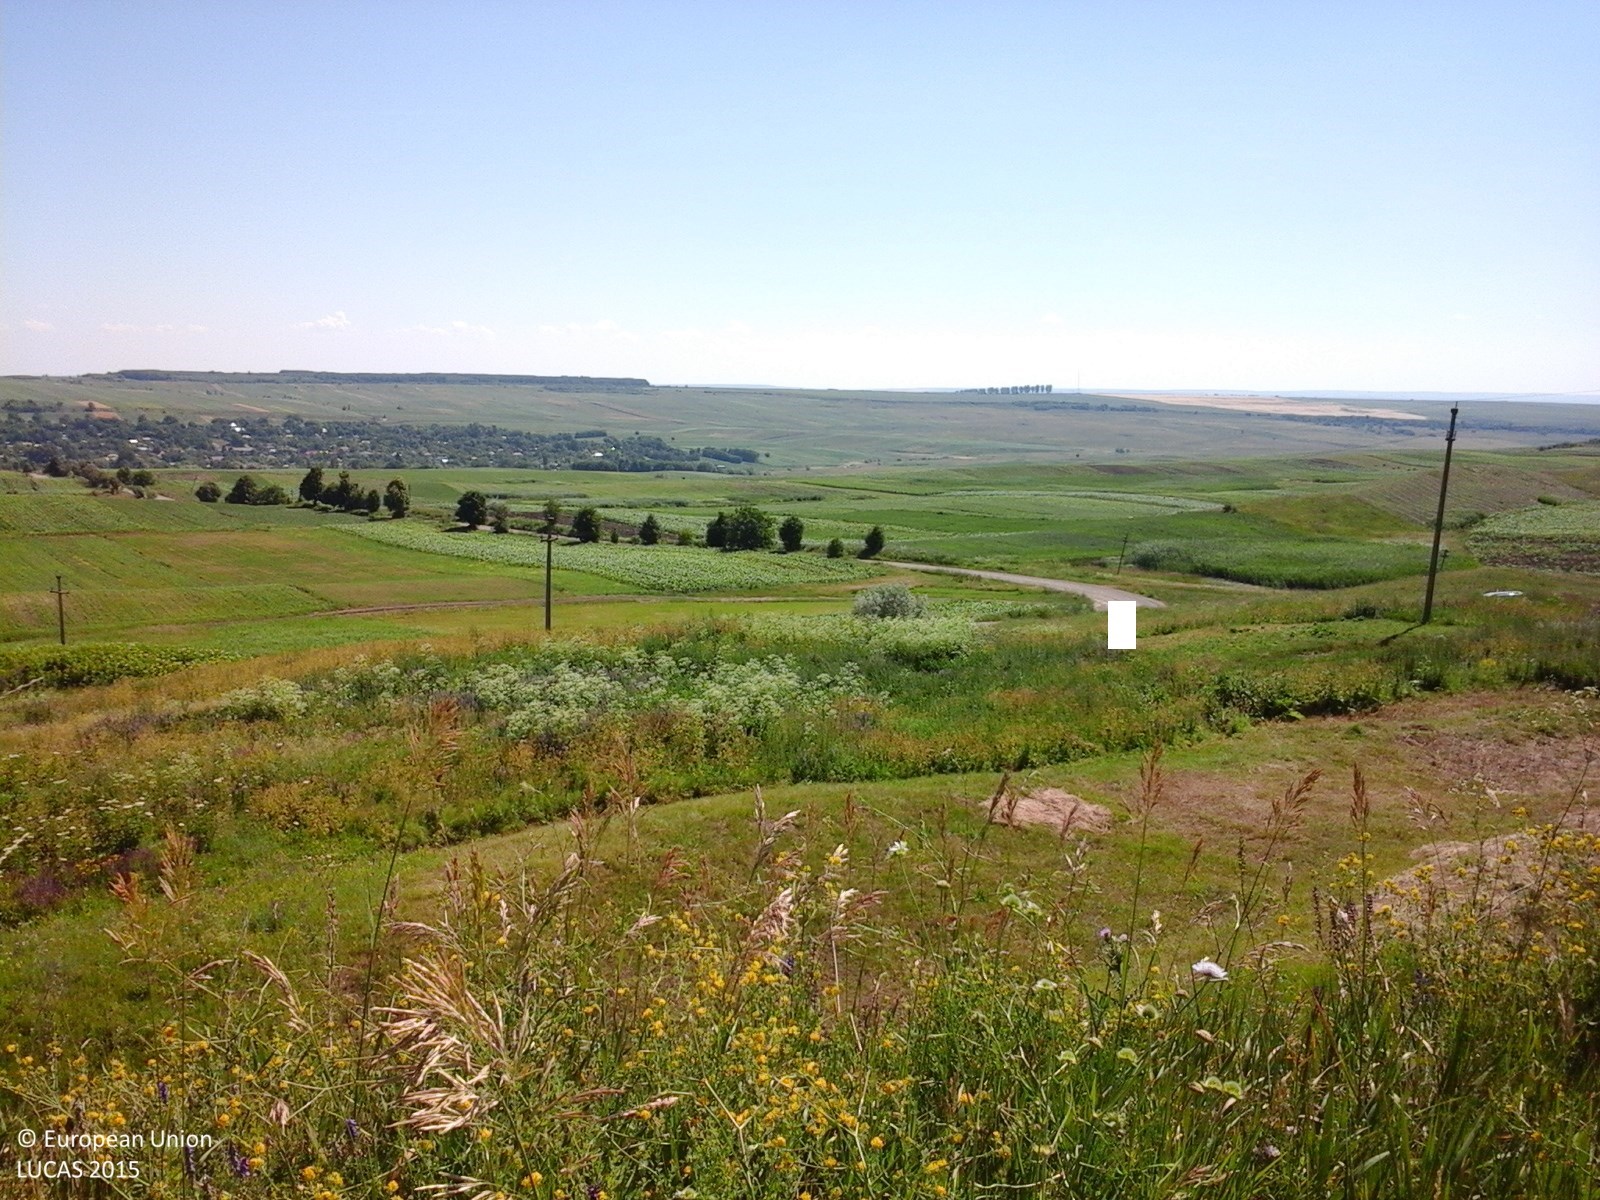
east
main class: Grassland
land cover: Grassland without tree/shrub cover
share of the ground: > 75 %
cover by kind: herbaceous plants 100 %
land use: Agriculture (excluding fallow land and kitchen gardens)
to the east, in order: Grassland without tree/shrub cover; Spontaneously vegetated surfaces; Electric lines; Spontaneously vegetated surfaces; Tracks; Grassland without tree/shrub cover; Tracks; Grassland without tree/shrub cover; Tracks; Grass margins; Maize; Grass margins; Tracks; Grass margins; Grassland without tree/shrub cover; Ditches and canals; Grass margins; Tracks; Spontaneously vegetated surfaces; Oats
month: June
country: RO
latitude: 48.1435
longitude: 26.8627
